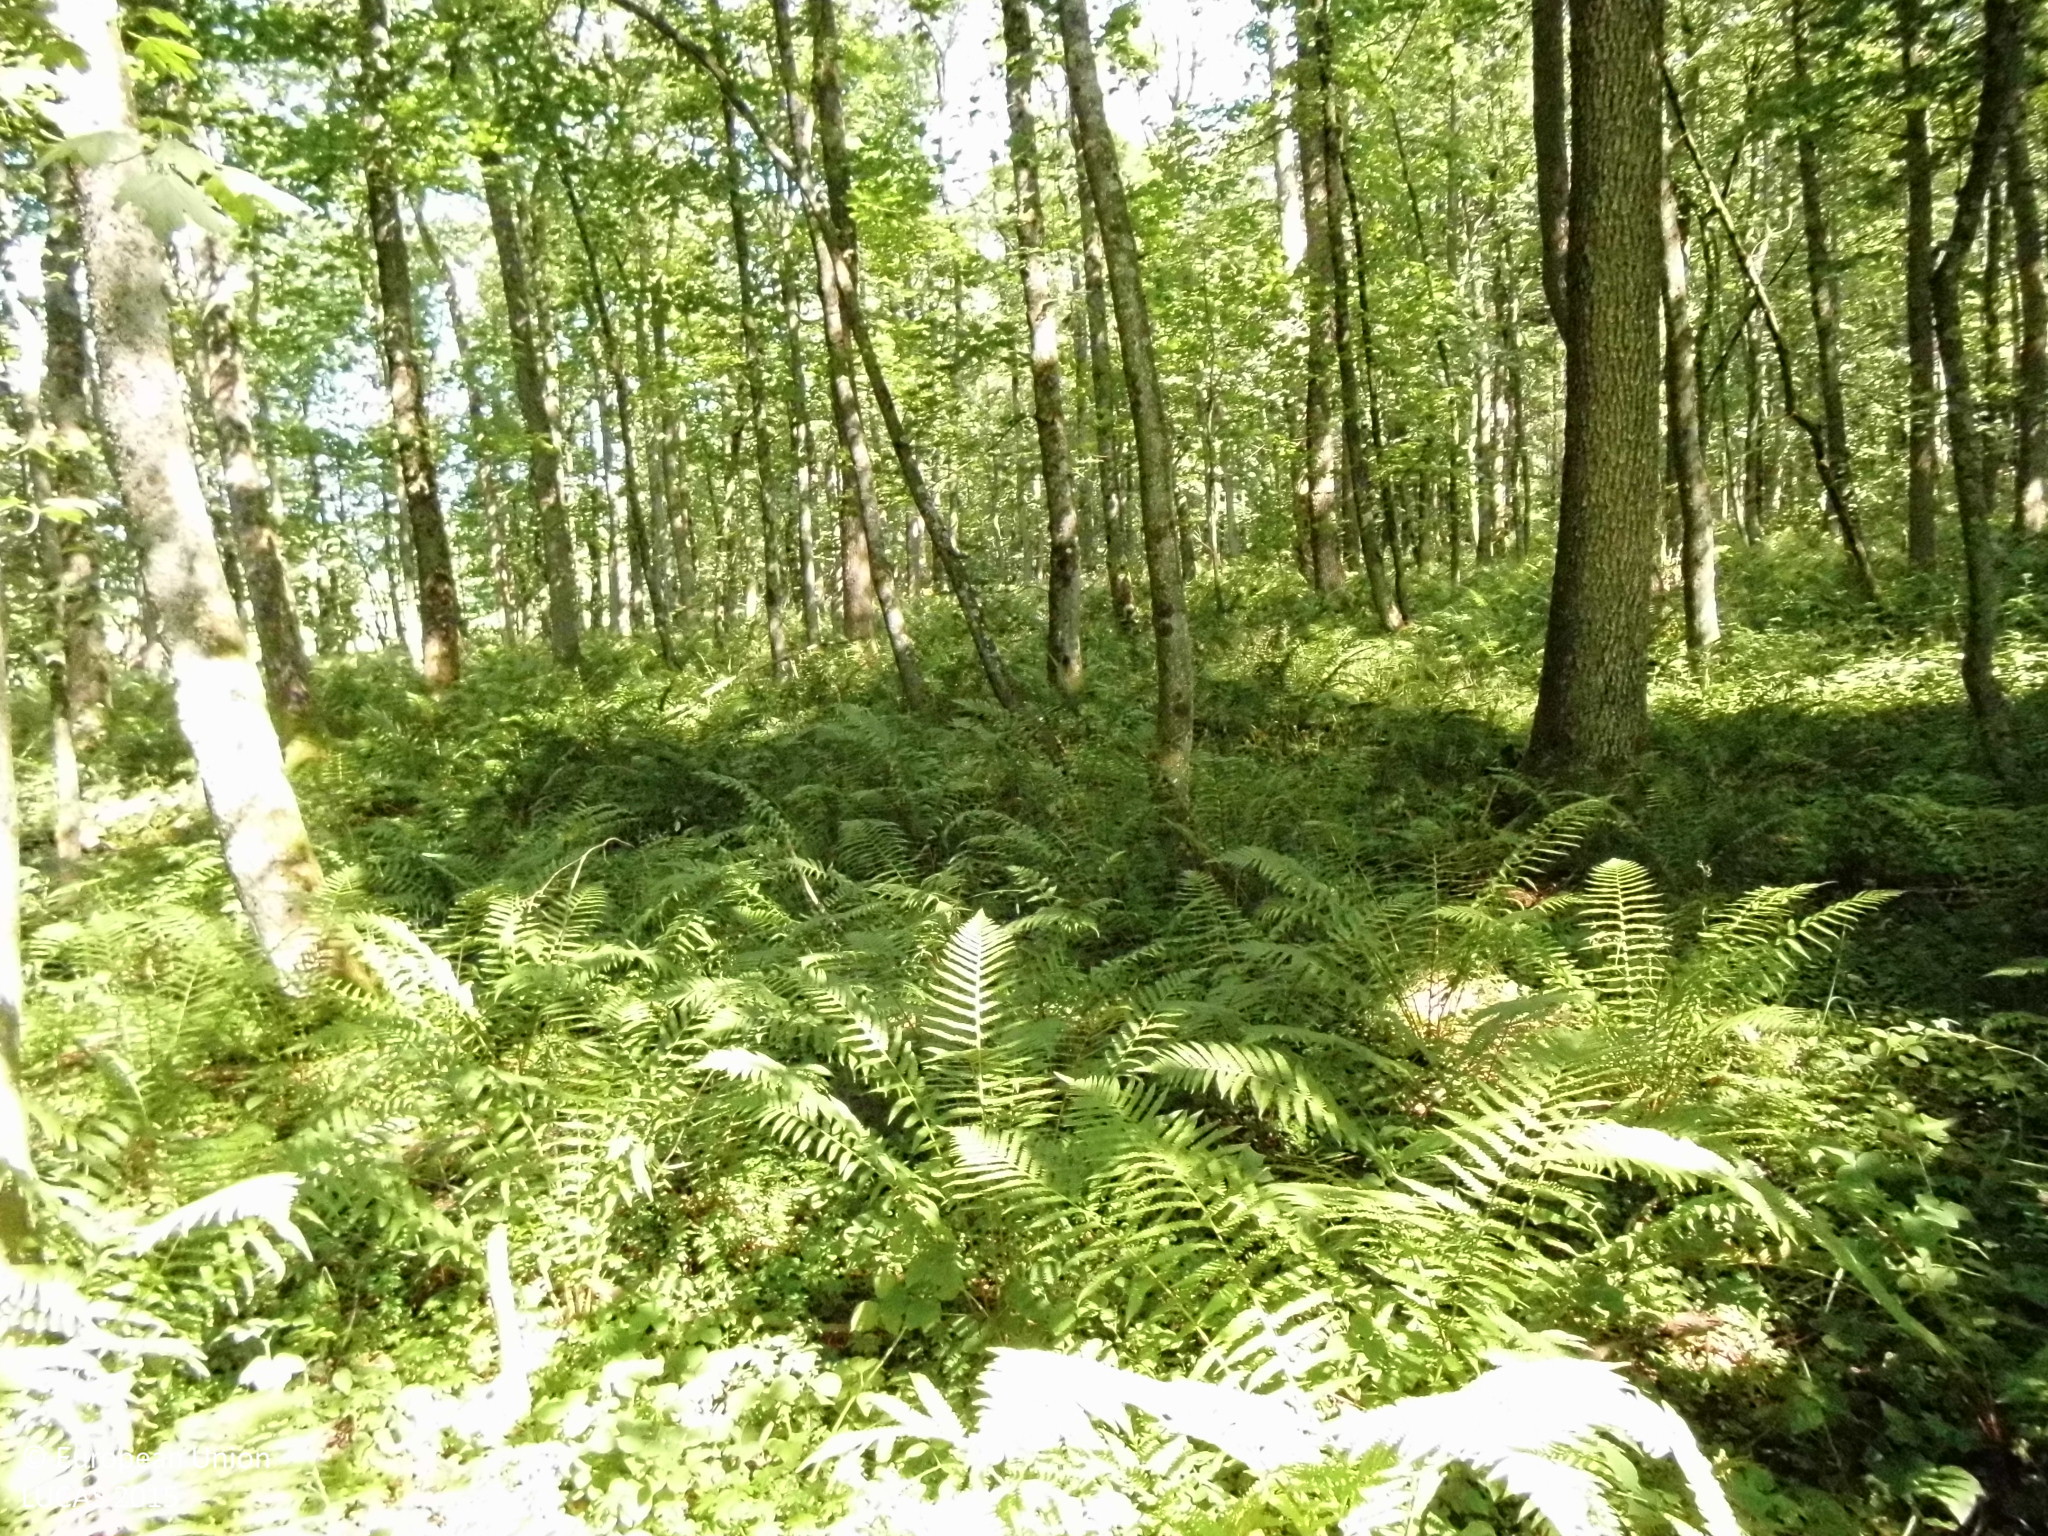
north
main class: Woodland
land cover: Broadleaved woodland
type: mesophytic deciduous forest
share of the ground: > 75 %
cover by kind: broadleaved forest trees 80 %, herbaceous plants 20 %
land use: Forestry
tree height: > 5 m
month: August
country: DE
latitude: 50.6539
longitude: 8.0909
